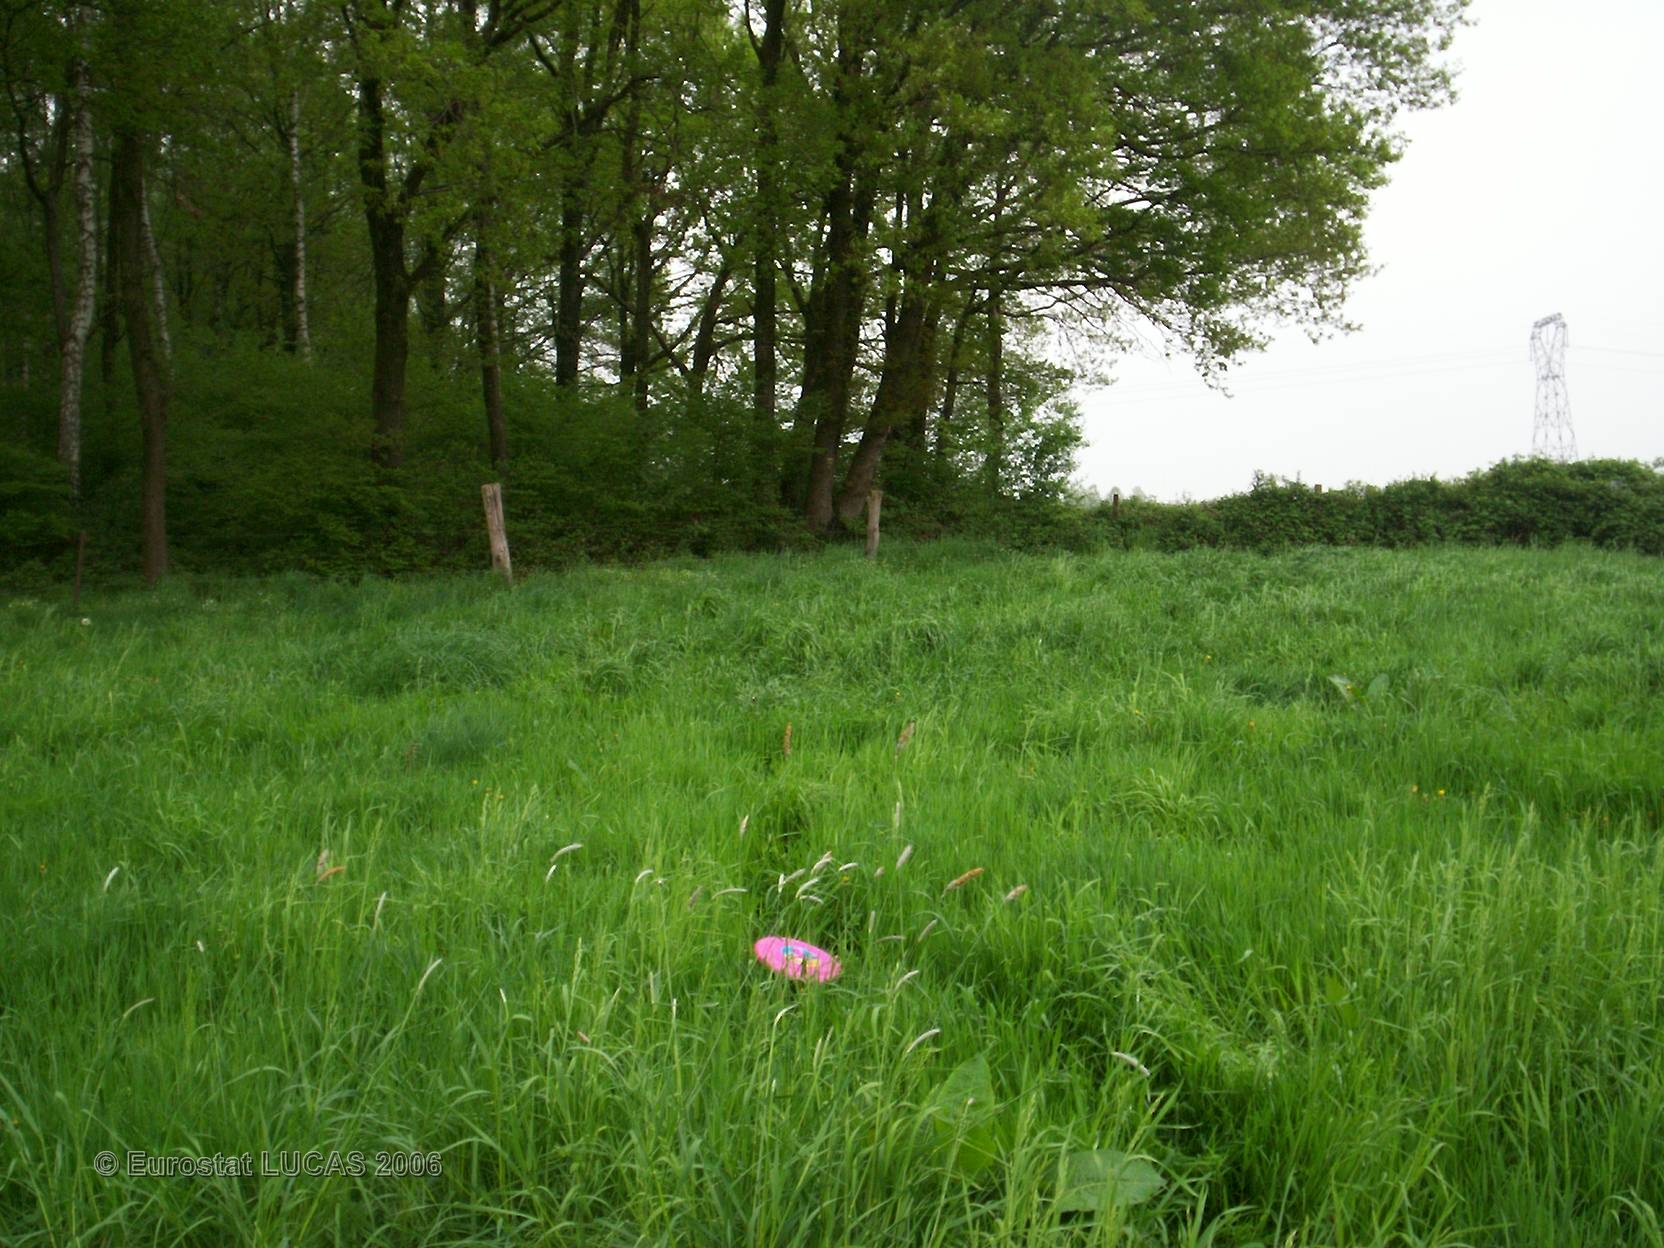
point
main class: Grassland
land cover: Grassland without tree/shrub cover
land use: Agriculture (excluding fallow land and kitchen gardens)
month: May
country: FR
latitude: 49.7589
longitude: 4.7913
